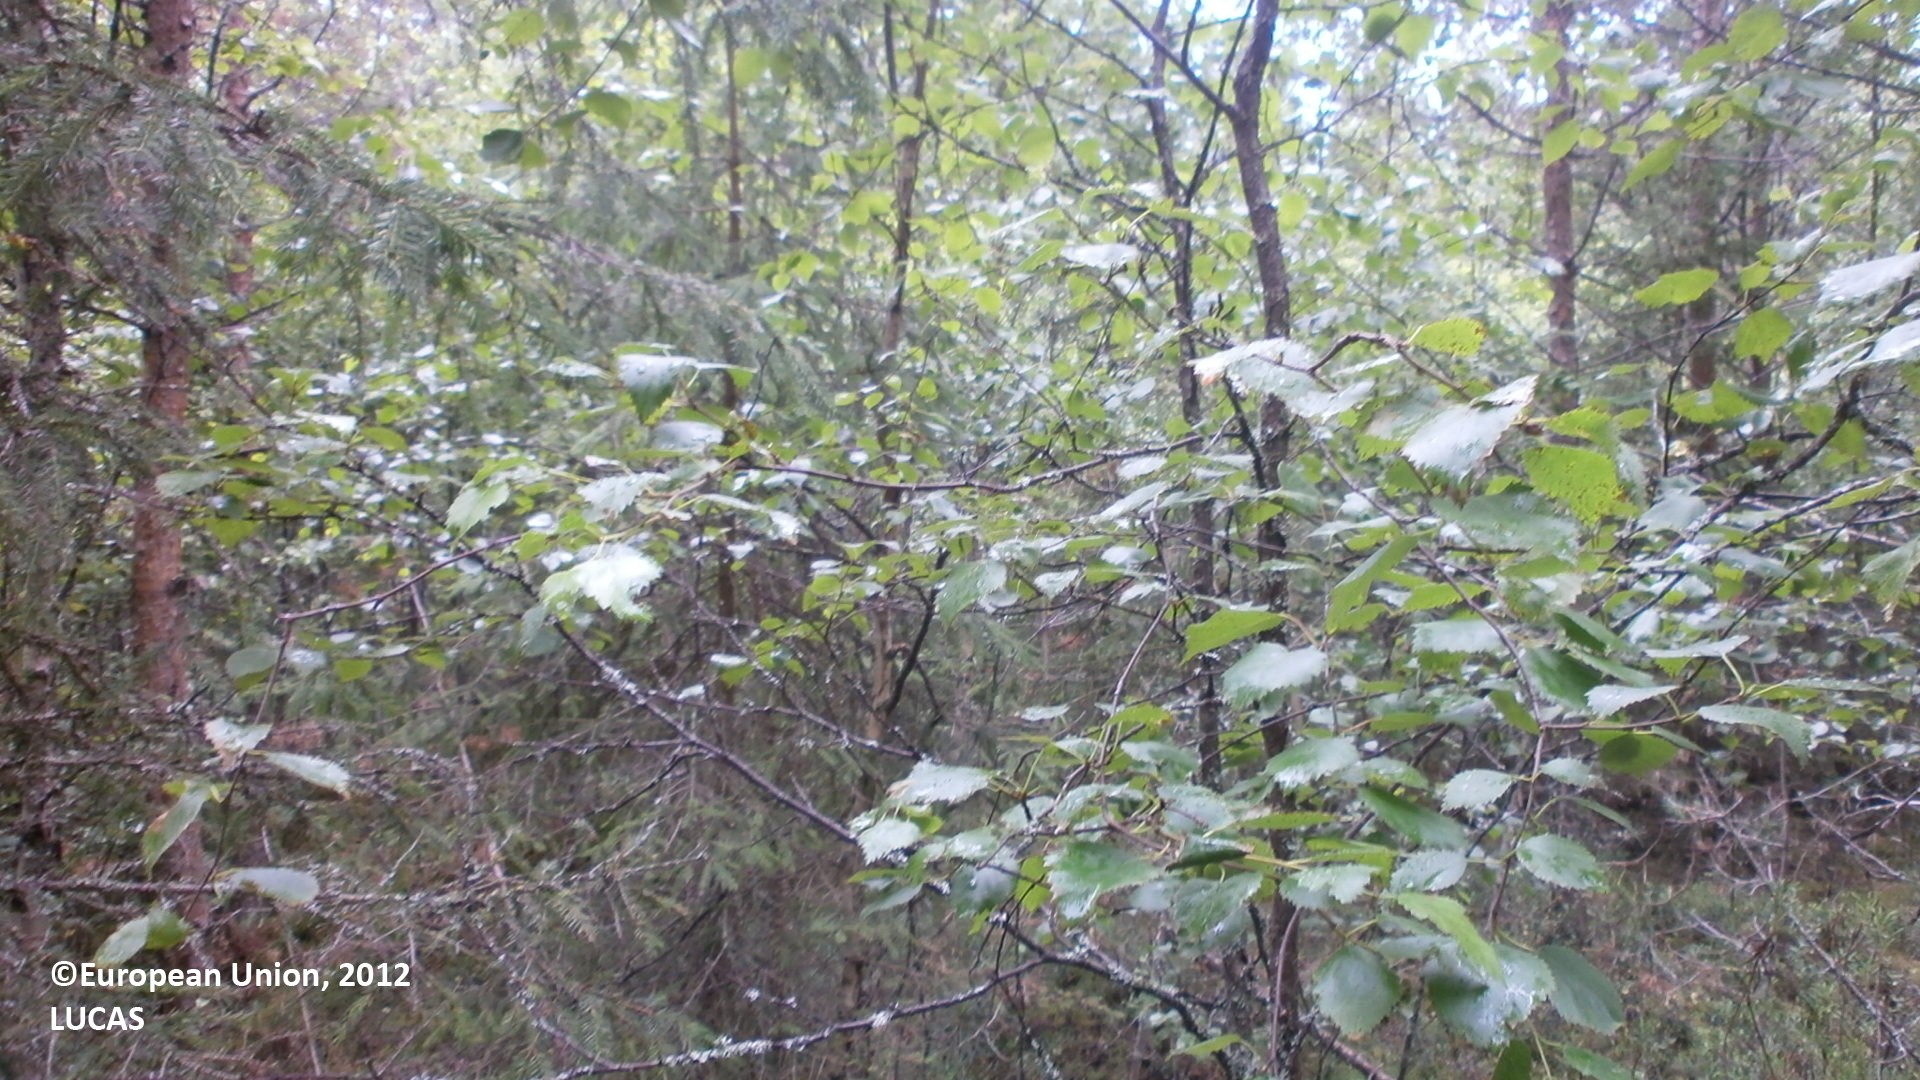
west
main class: Woodland
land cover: Pine dominated mixed woodland
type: boreal forest
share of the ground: 50 - 75 %
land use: Forestry
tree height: > 5 m
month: July
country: FI
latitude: 64.2694
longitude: 24.4183
